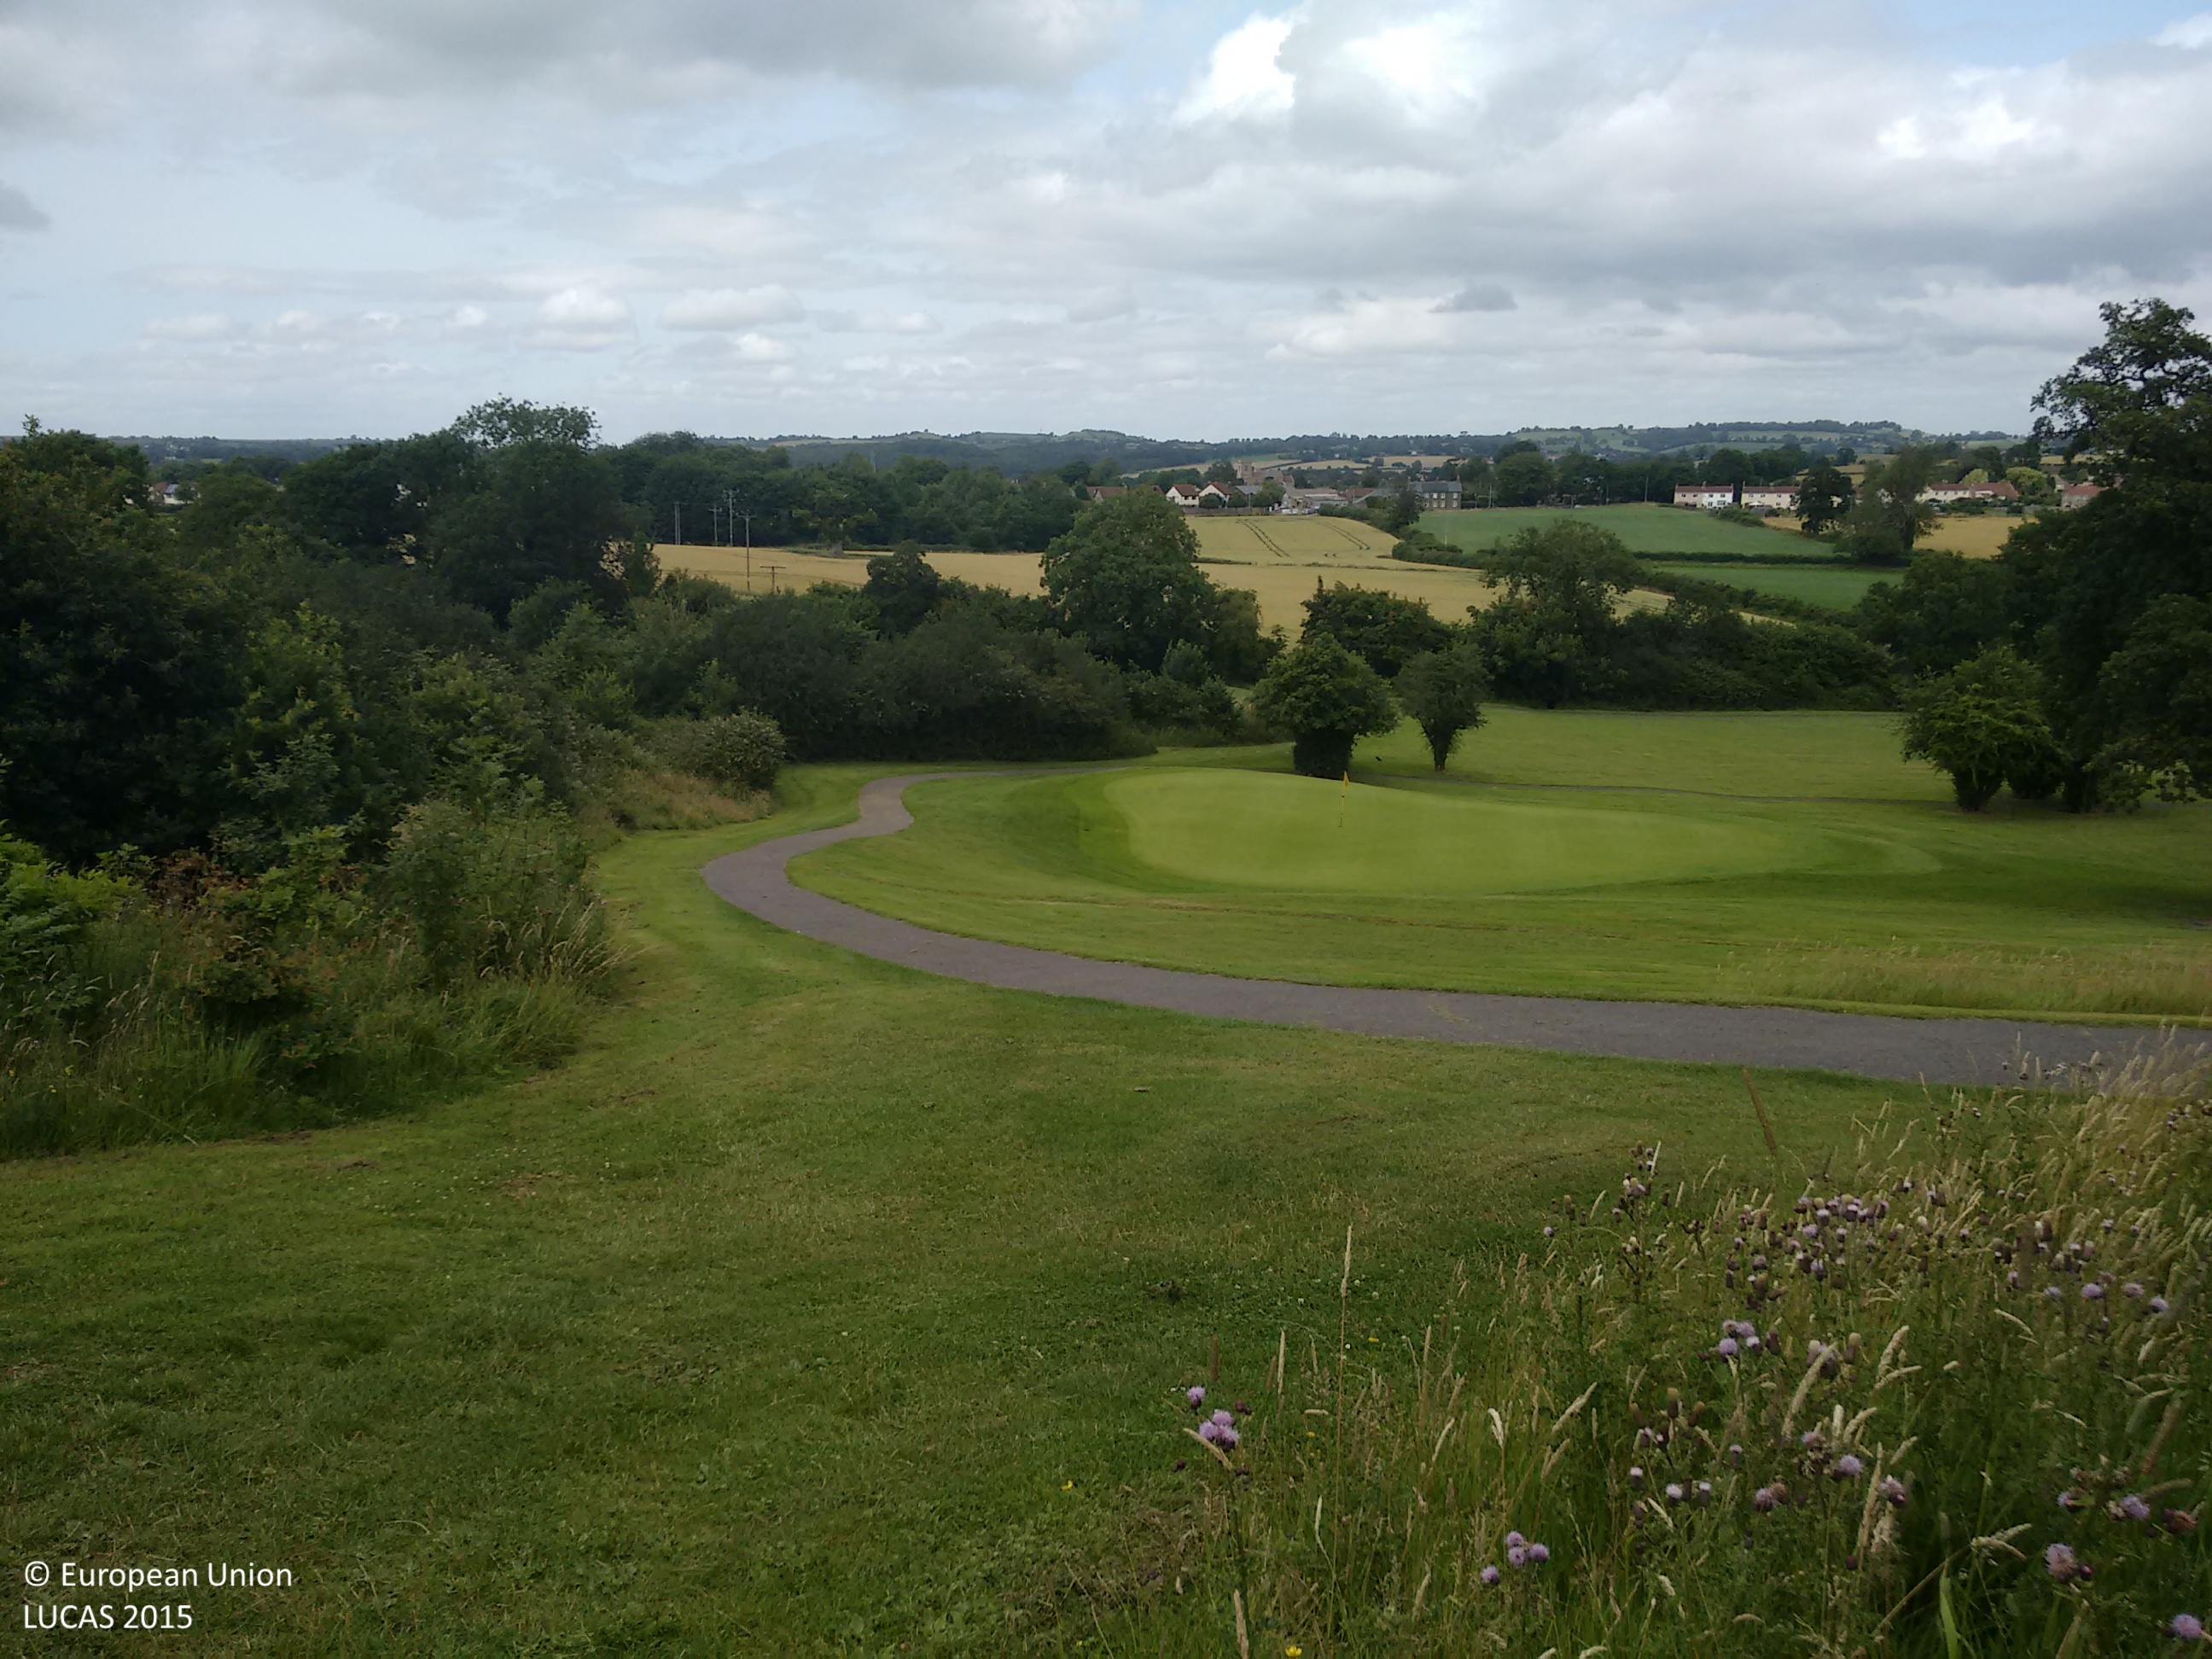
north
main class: Grassland
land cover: Grassland without tree/shrub cover
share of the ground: > 75 %
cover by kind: herbaceous plants 100 %
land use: Sport
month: July
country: GB
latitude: 51.2918
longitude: -2.5284
